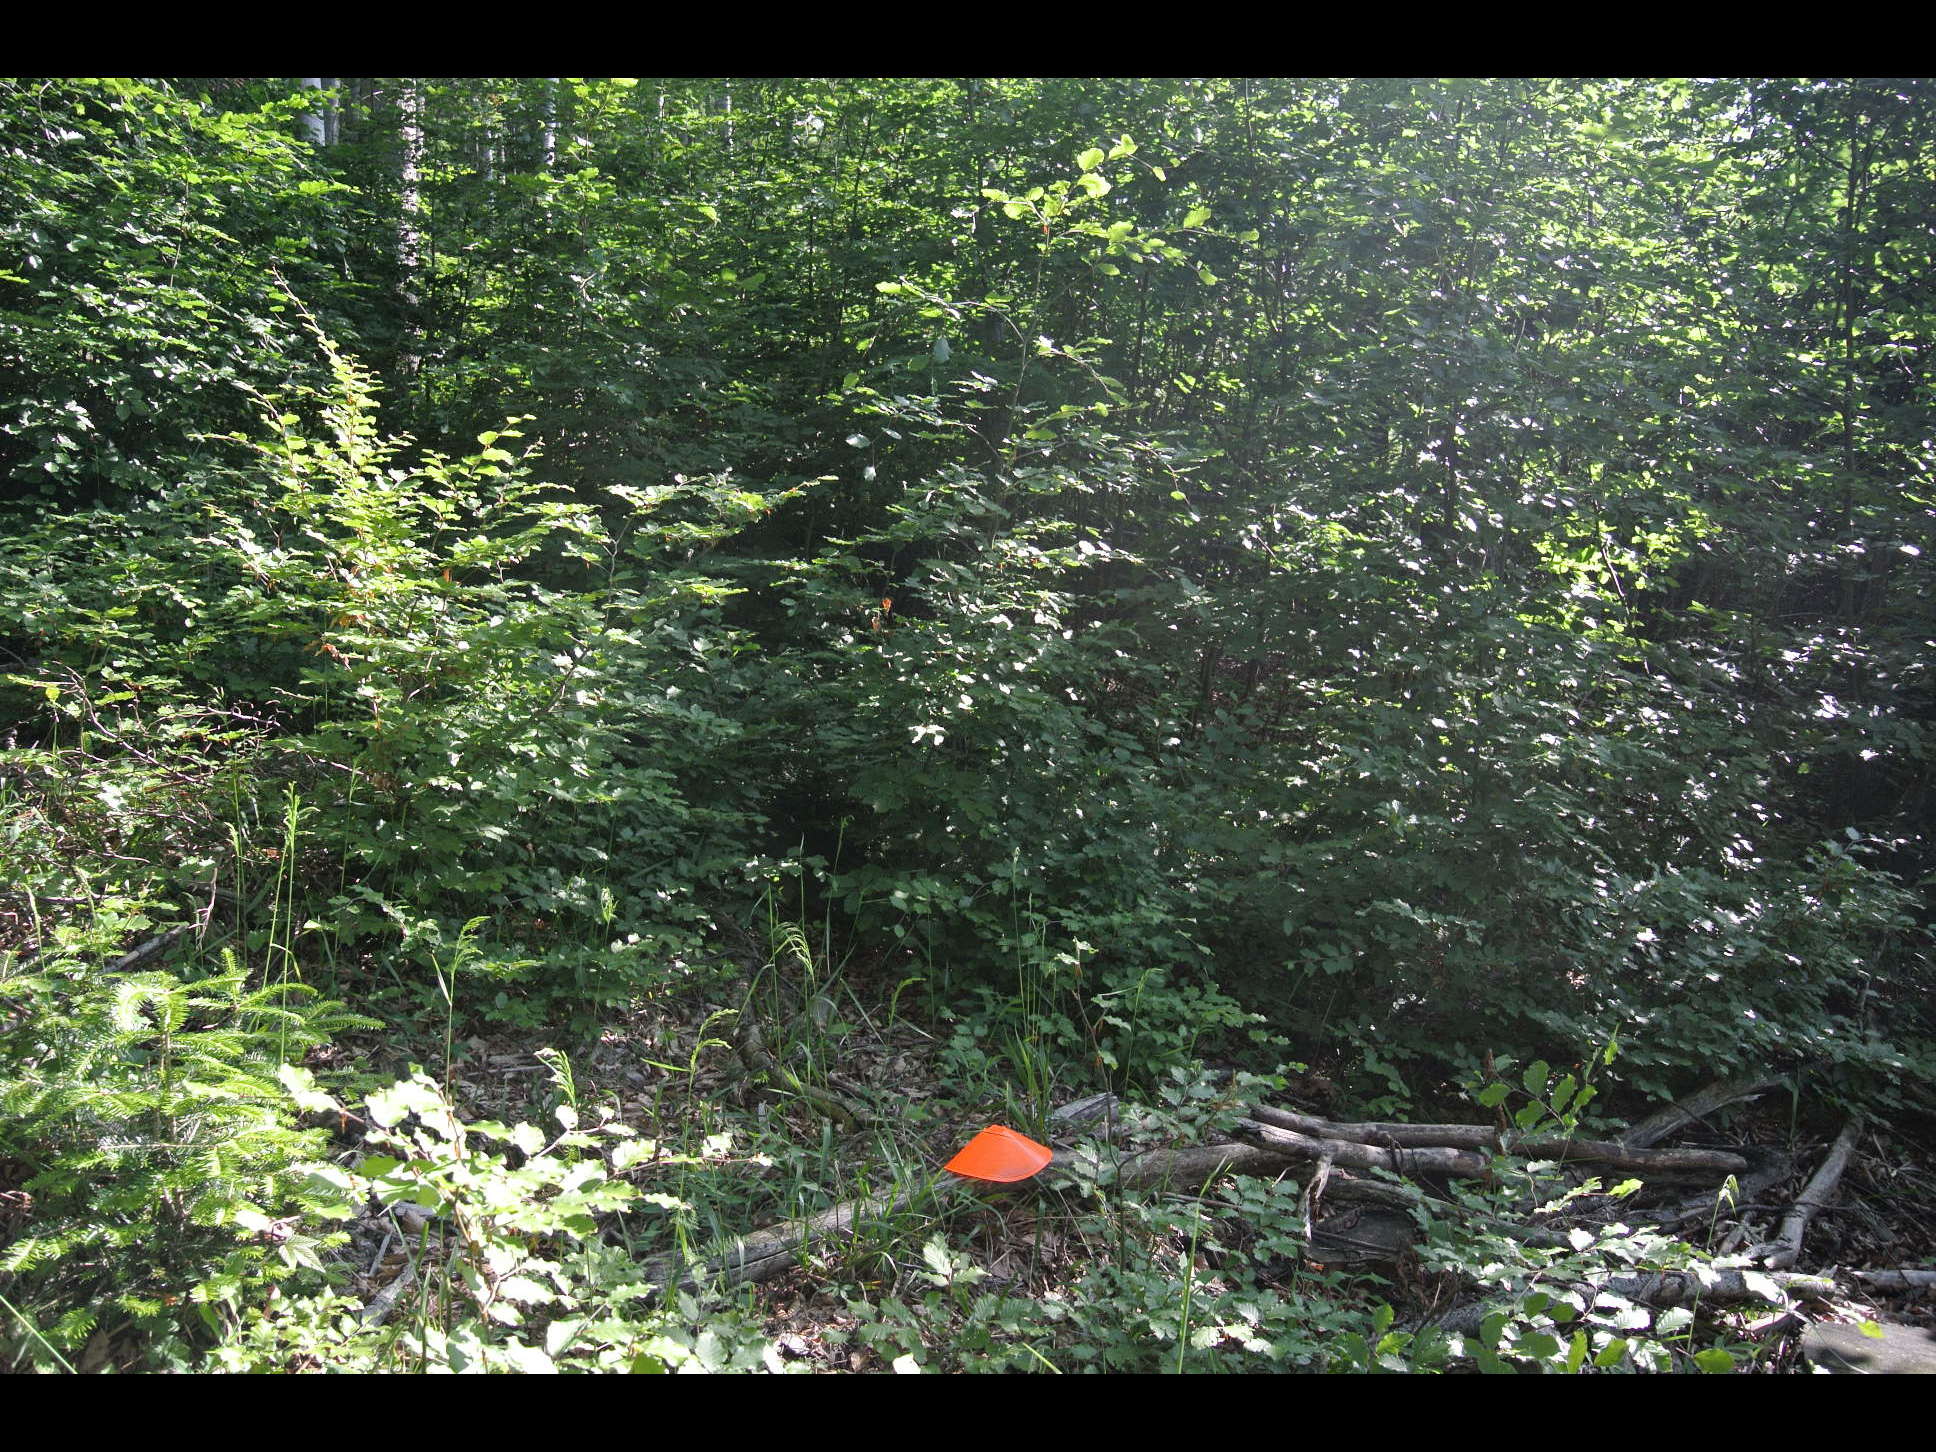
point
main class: Woodland
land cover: Spruce dominated mixed woodland
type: alpine coniferous forest
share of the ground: > 75 %
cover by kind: coniferous forest trees 60 %, broadleaved forest trees 40 %
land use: Forestry
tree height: > 5 m
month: May
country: AT
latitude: 48.0687
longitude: 15.8408
